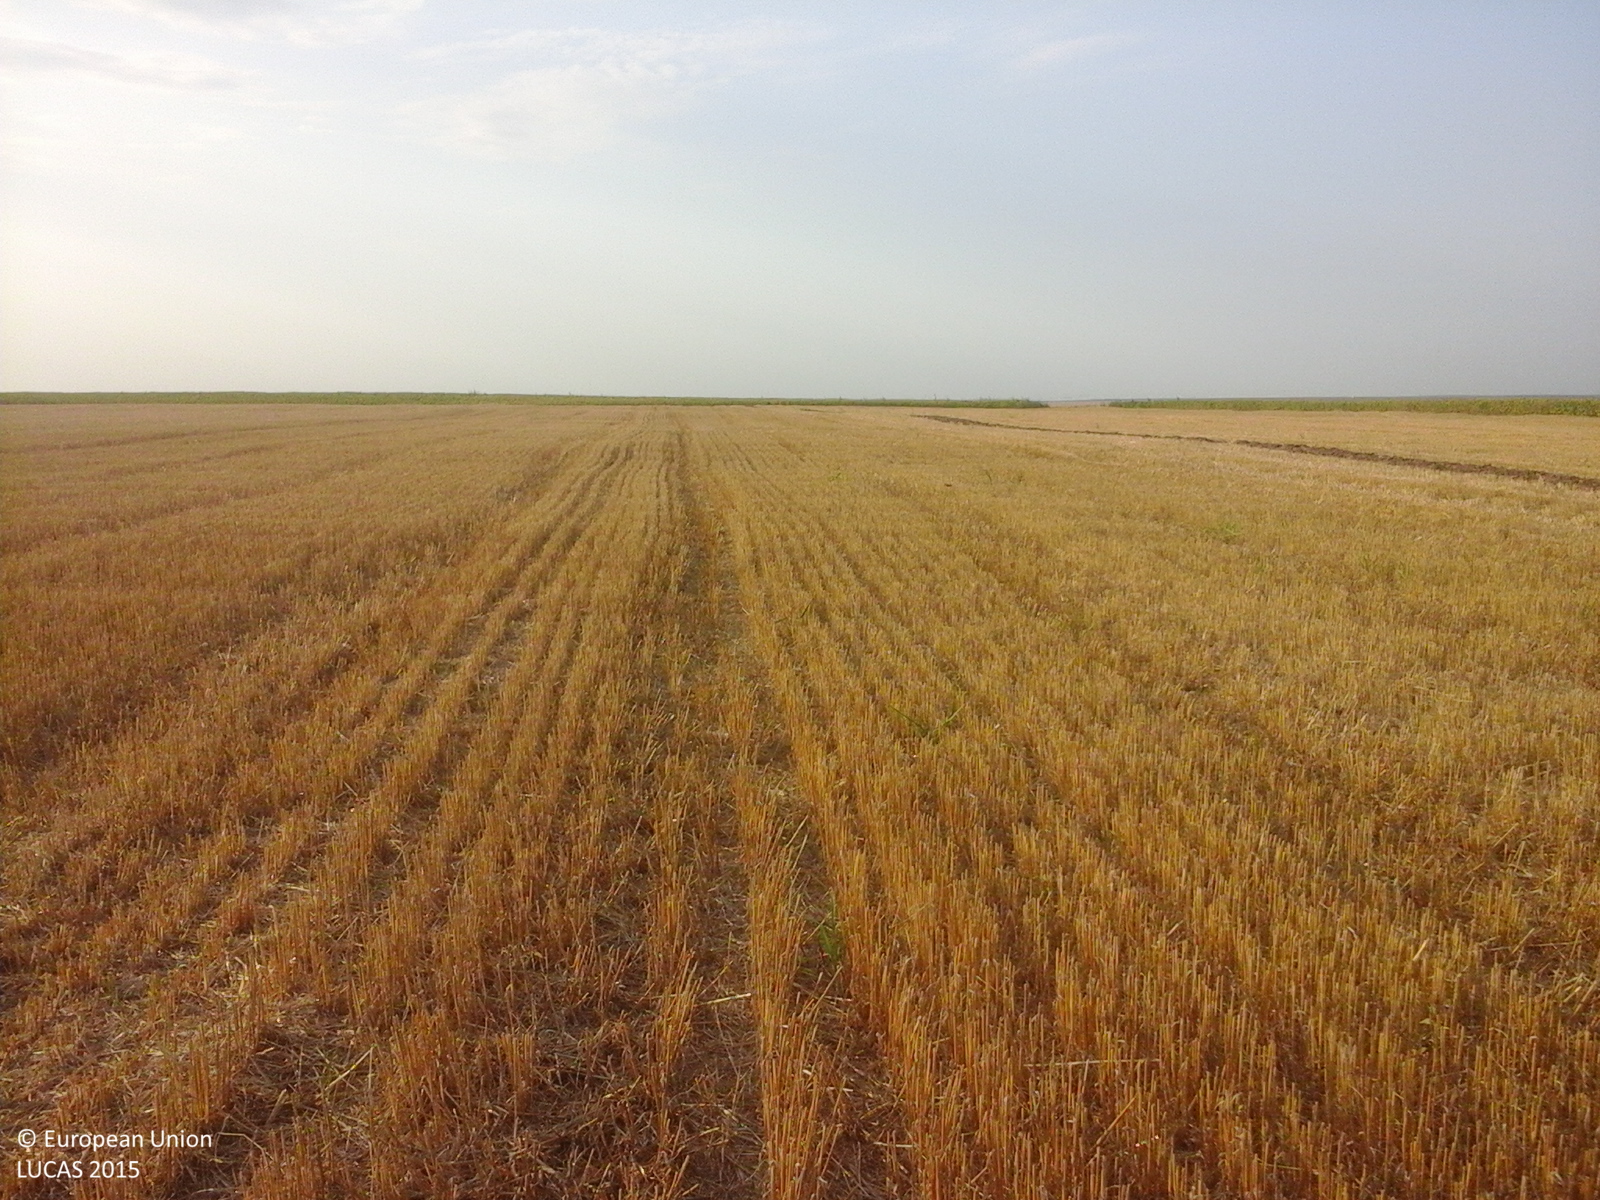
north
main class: Cropland
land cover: Barley
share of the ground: > 75 %
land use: Agriculture (excluding fallow land and kitchen gardens)
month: August
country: RO
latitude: 44.0406
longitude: 28.0622
